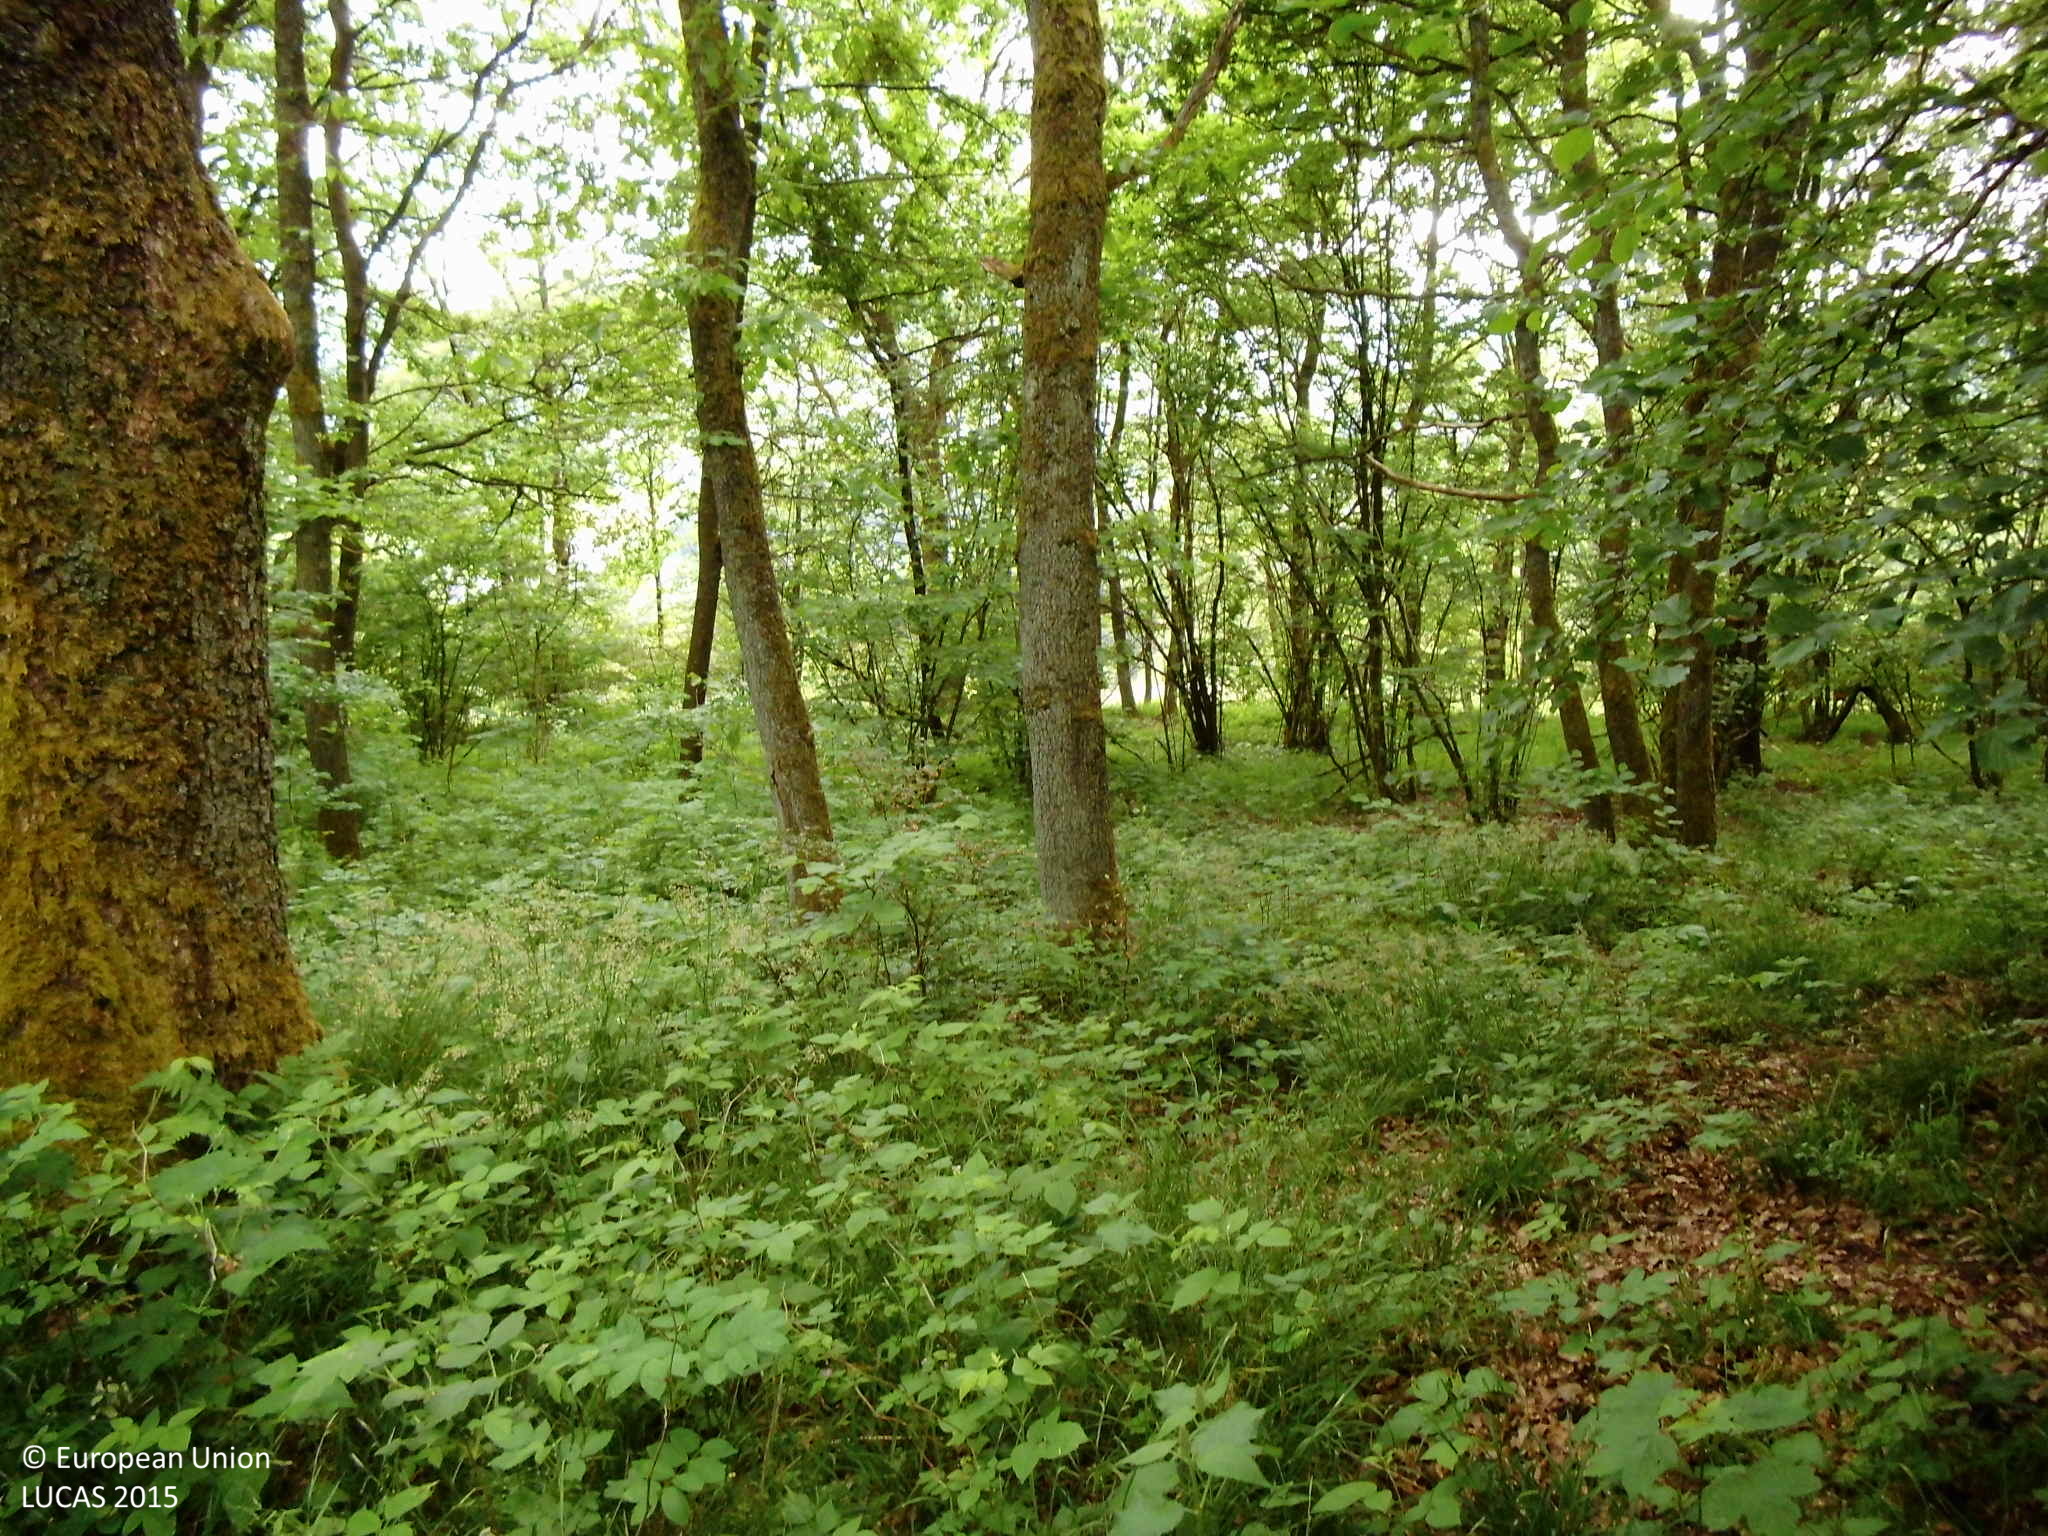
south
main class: Woodland
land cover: Broadleaved woodland
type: mesophytic deciduous forest
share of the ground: > 75 %
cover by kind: broadleaved forest trees 85 %, shrubs 10 %, herbaceous plants 5 %
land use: Forestry
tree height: > 5 m
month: June
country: DE
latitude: 51.0663
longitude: 8.0168
